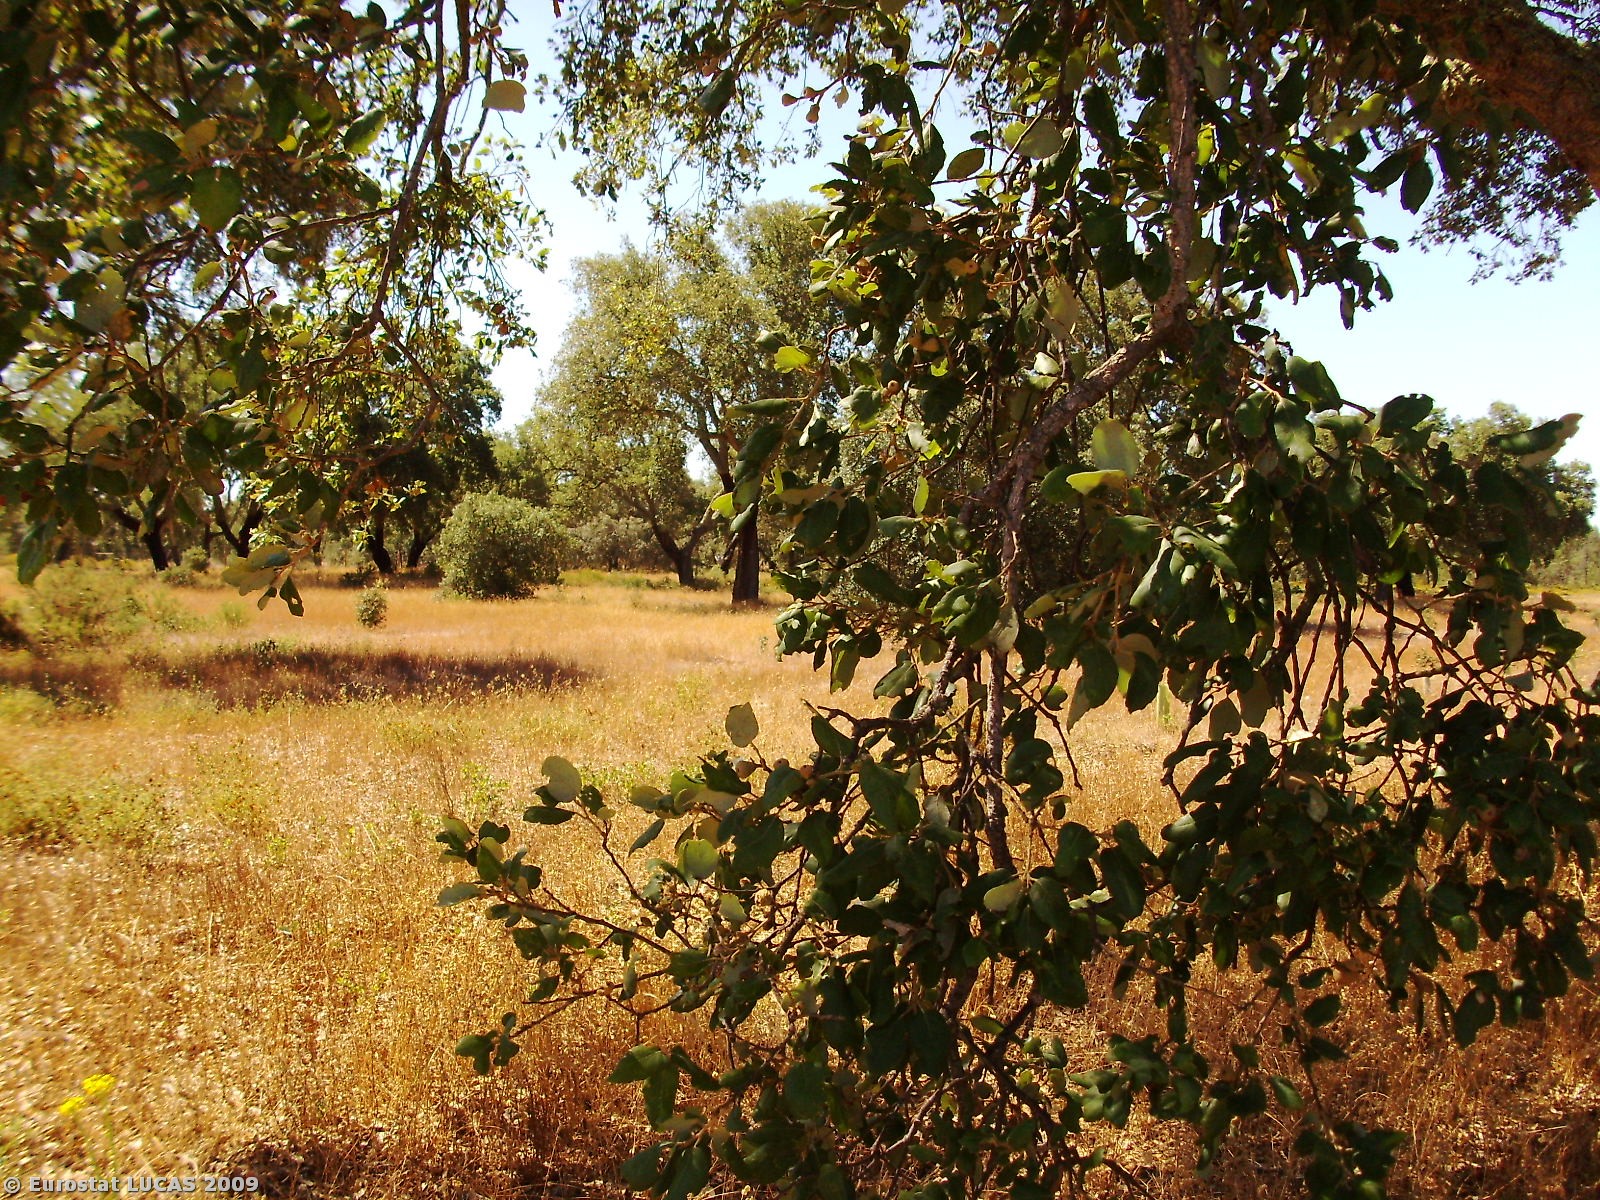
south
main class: Woodland
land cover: Broadleaved woodland
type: broadleaved evergreen forest
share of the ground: 25 - 50 %
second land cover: Spontaneously vegetated surfaces
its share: 25 - 50 %
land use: Forestry
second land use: Fallow land
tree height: > 5 m
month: July
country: PT
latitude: 37.7886
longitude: -8.3977
